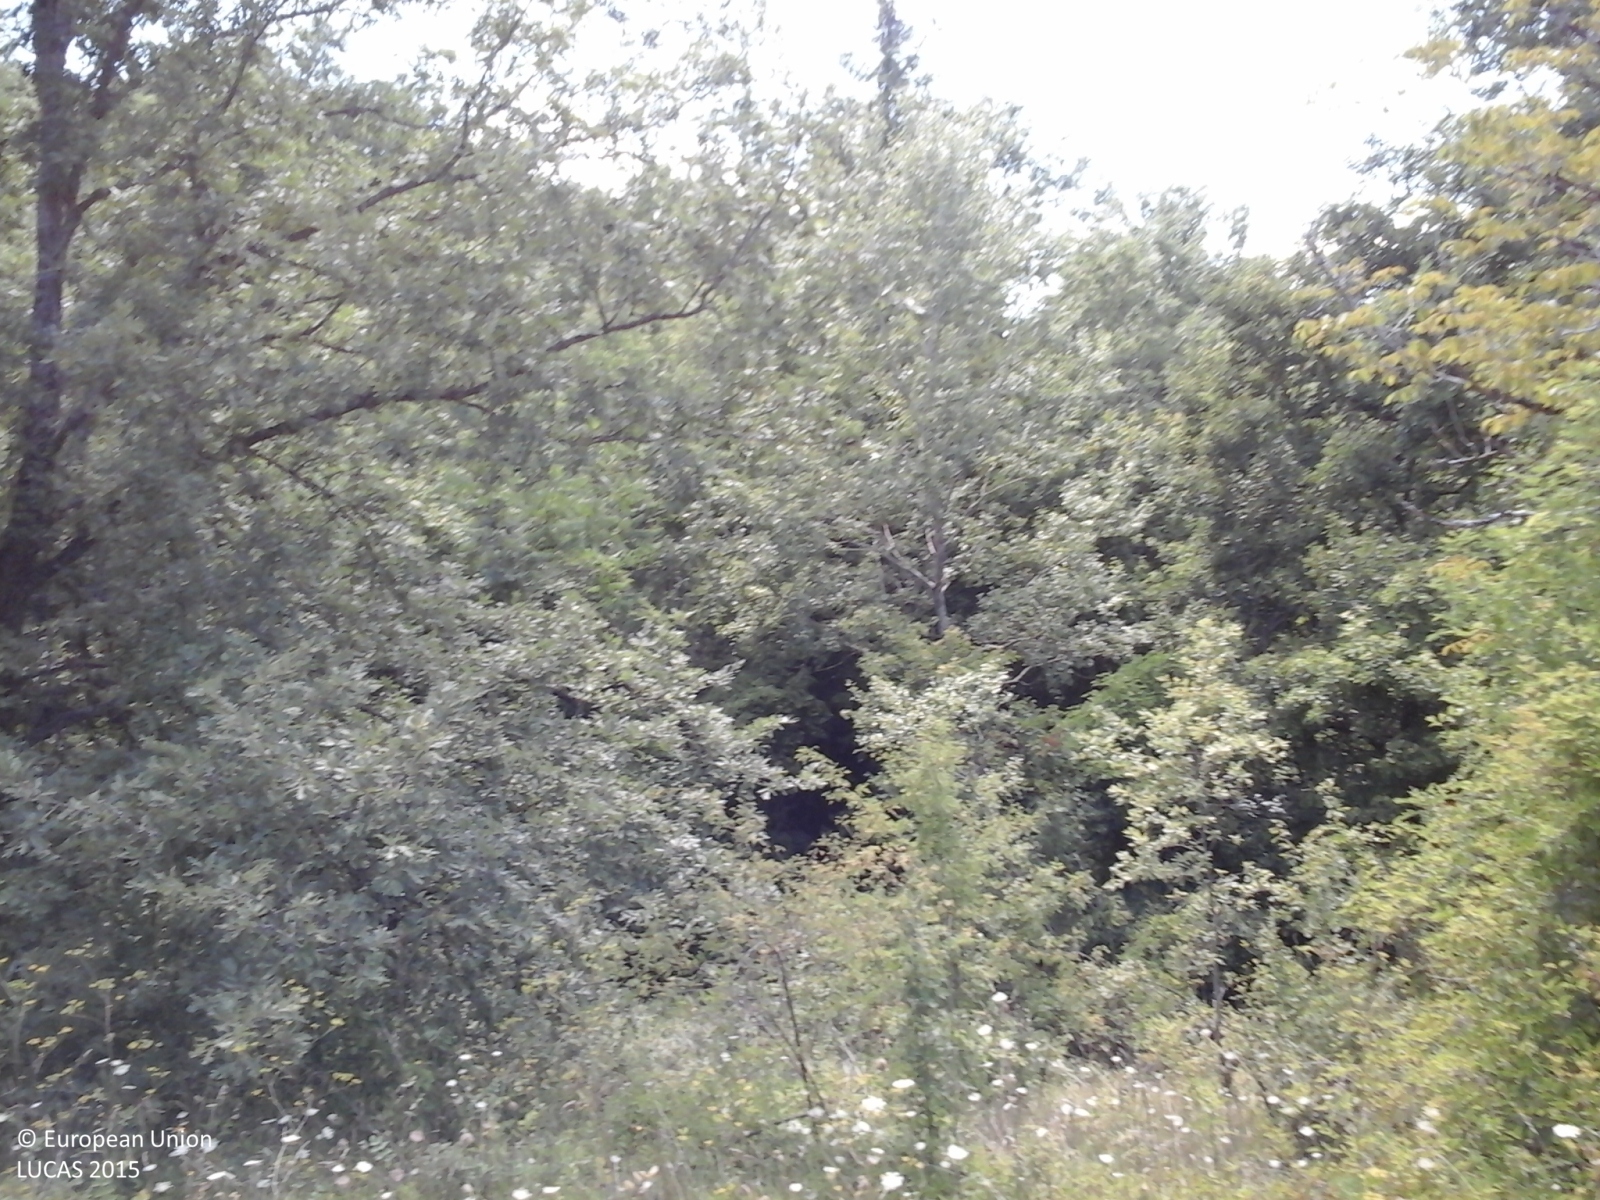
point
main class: Woodland
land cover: Broadleaved woodland
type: thermophilous deciduous forest
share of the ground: > 75 %
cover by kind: broadleaved forest trees 75 %, shrubs 20 %, herbaceous plants 5 %
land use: Semi-natural and natural areas not in use
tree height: > 5 m
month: August
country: IT
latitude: 41.5831
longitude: 14.3626
